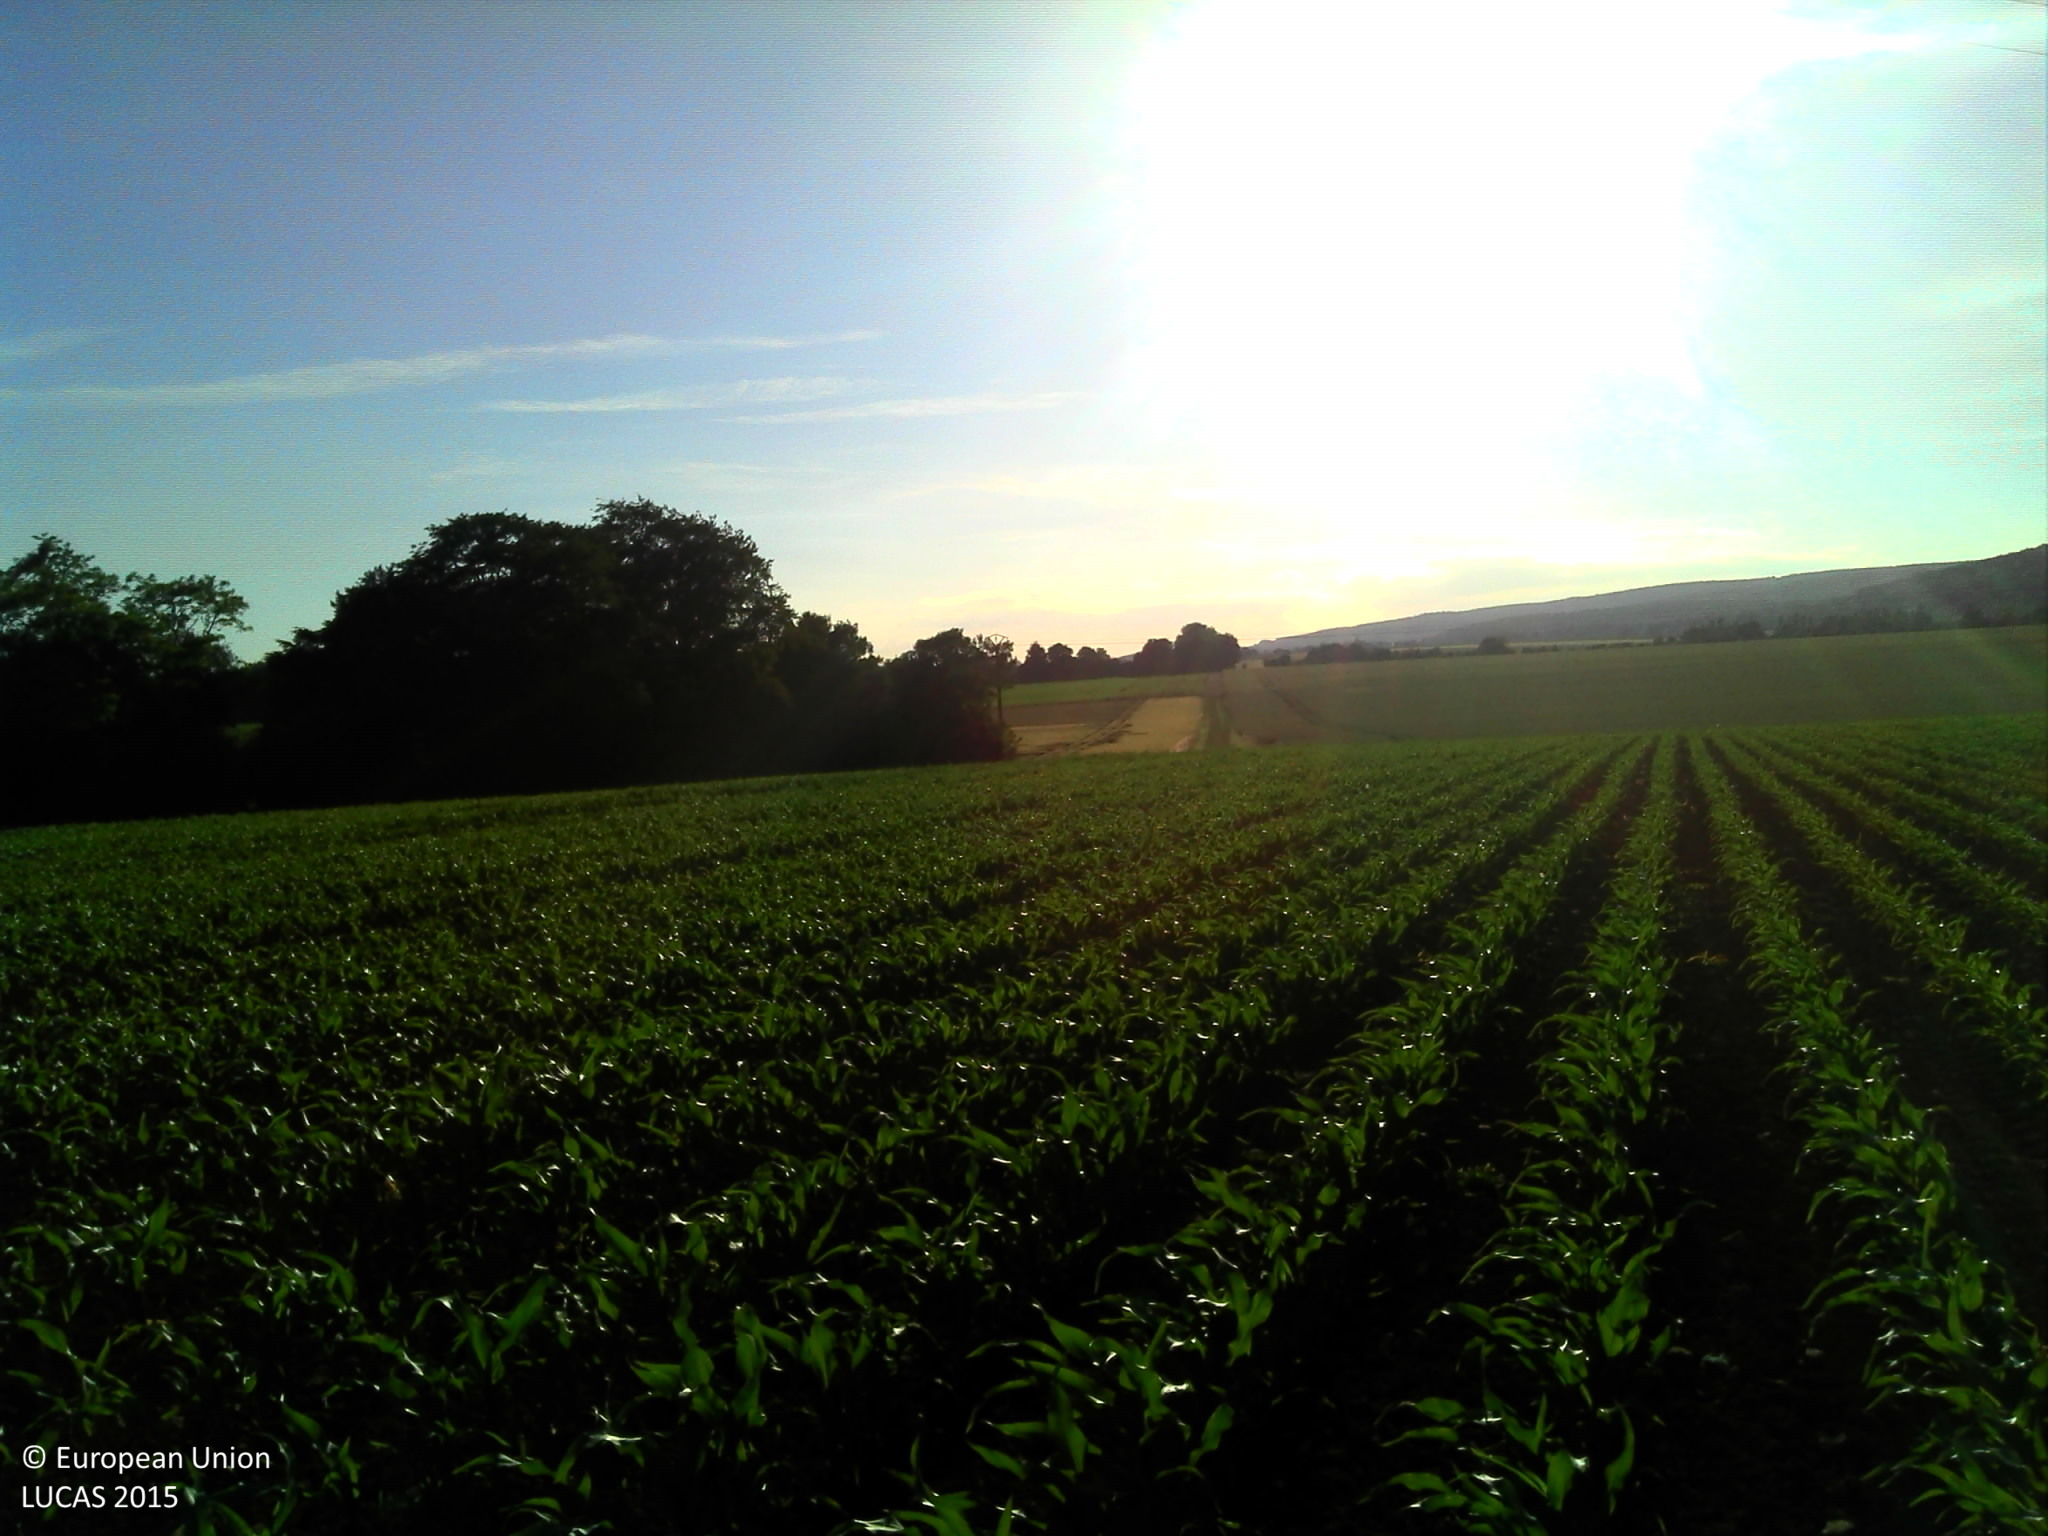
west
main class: Cropland
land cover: Maize
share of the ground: 25 - 50 %
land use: Agriculture (excluding fallow land and kitchen gardens)
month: June
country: FR
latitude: 48.4846
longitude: 0.1085
